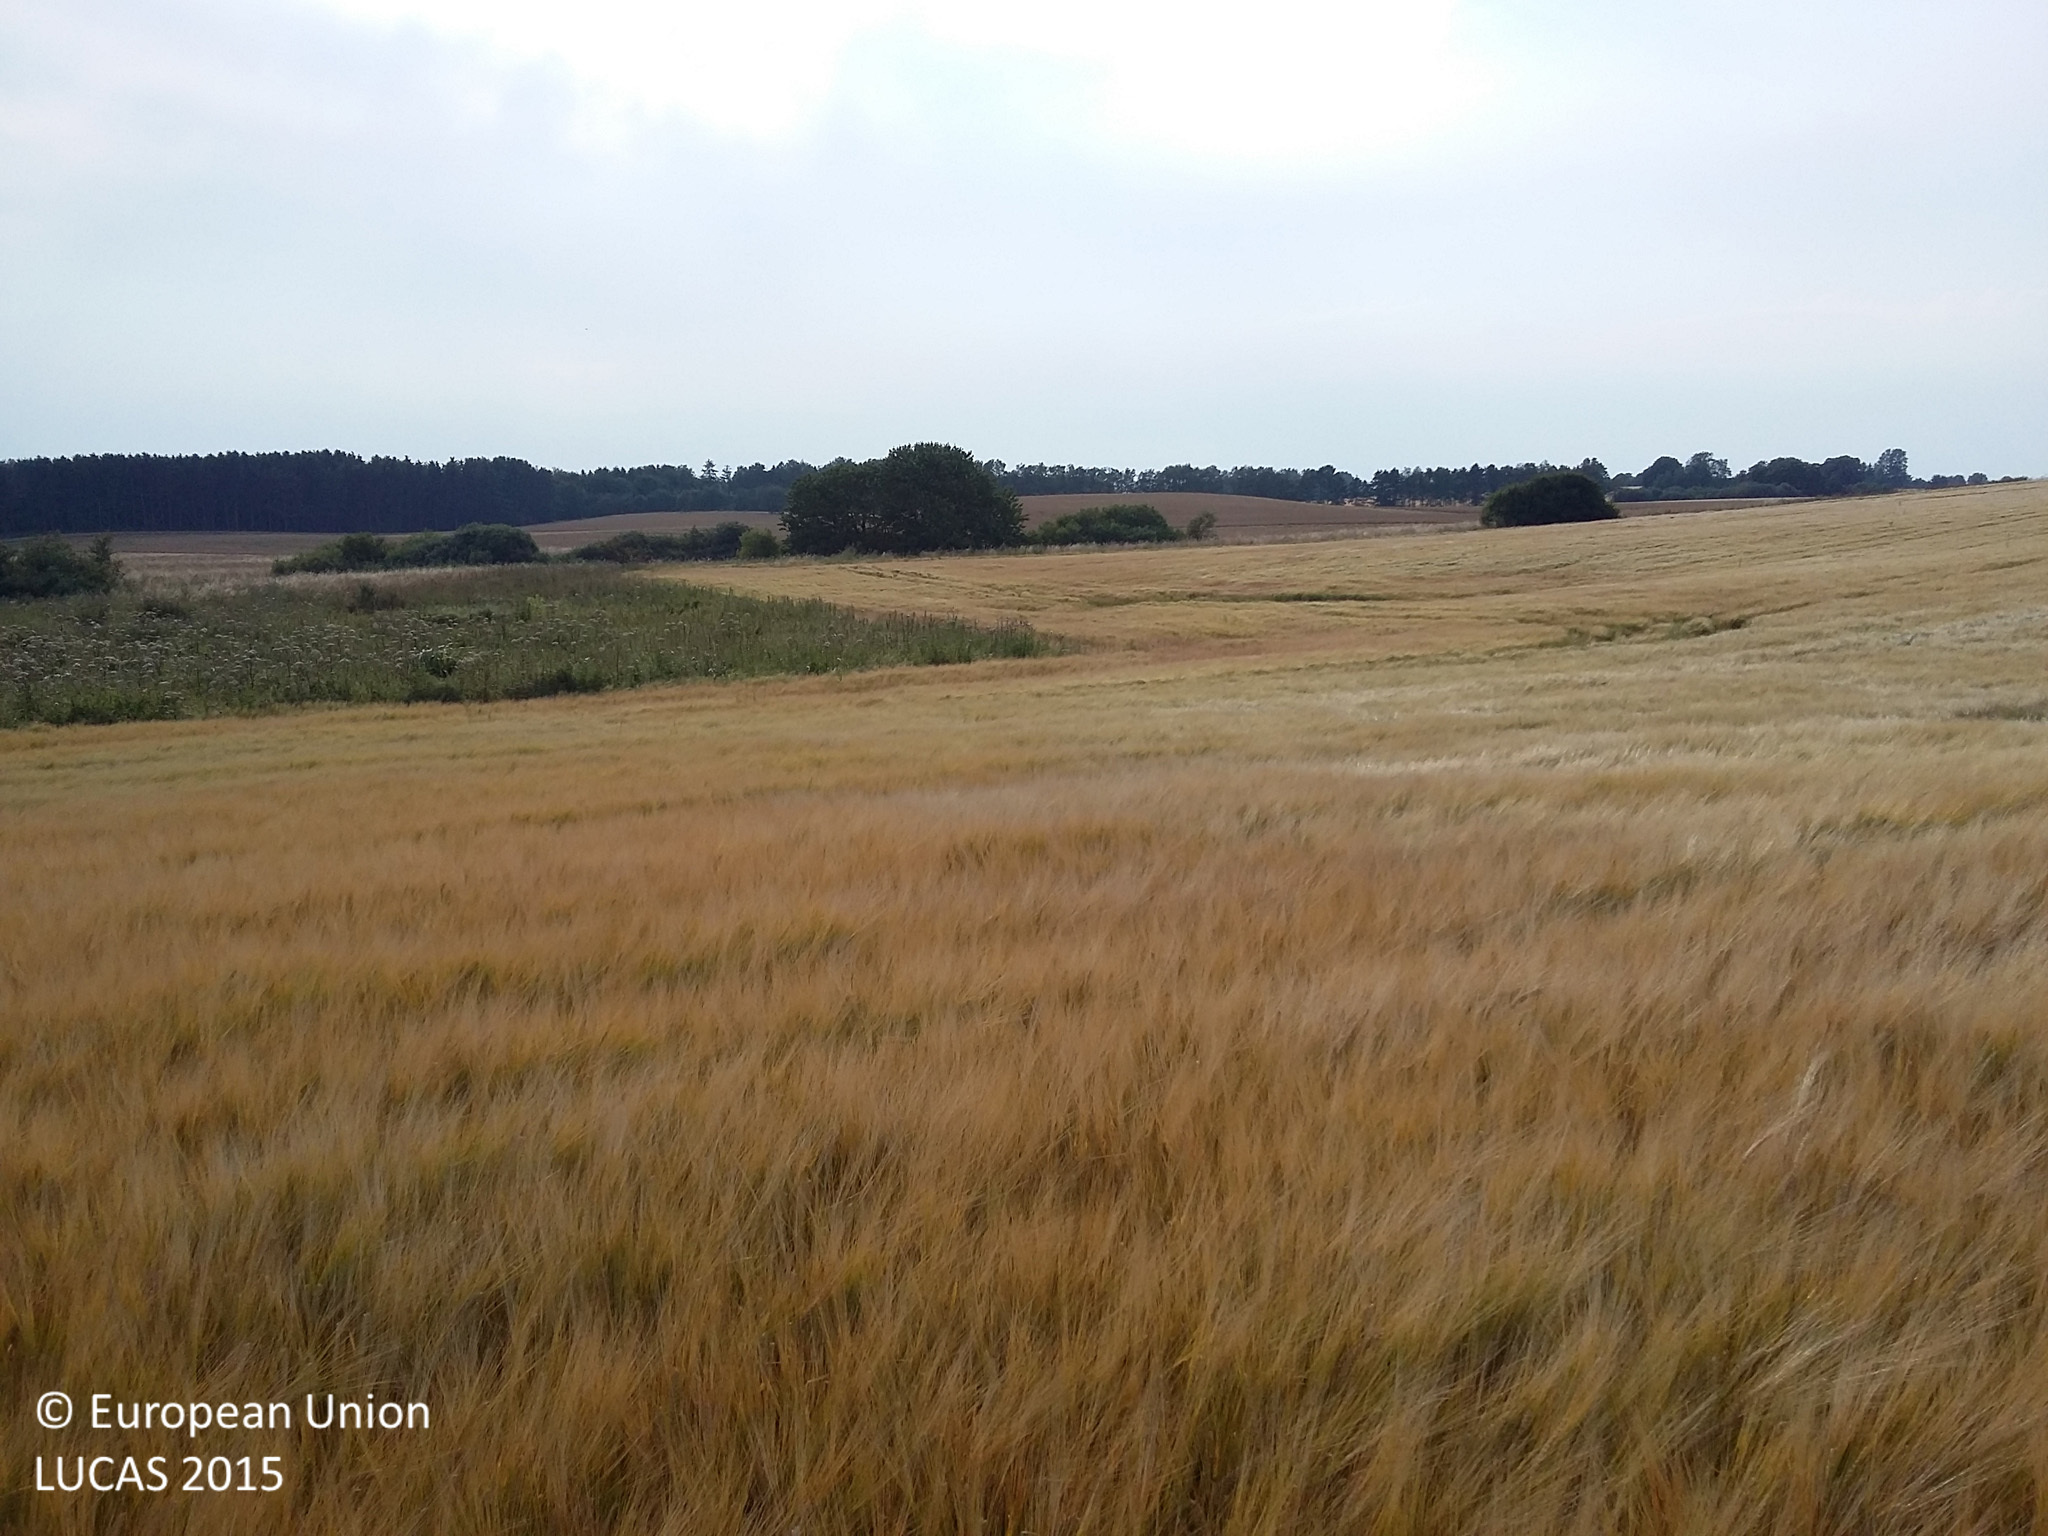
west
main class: Cropland
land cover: Barley
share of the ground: > 75 %
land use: Agriculture (excluding fallow land and kitchen gardens)
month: August
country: DK
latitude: 55.5092
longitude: 11.8511
